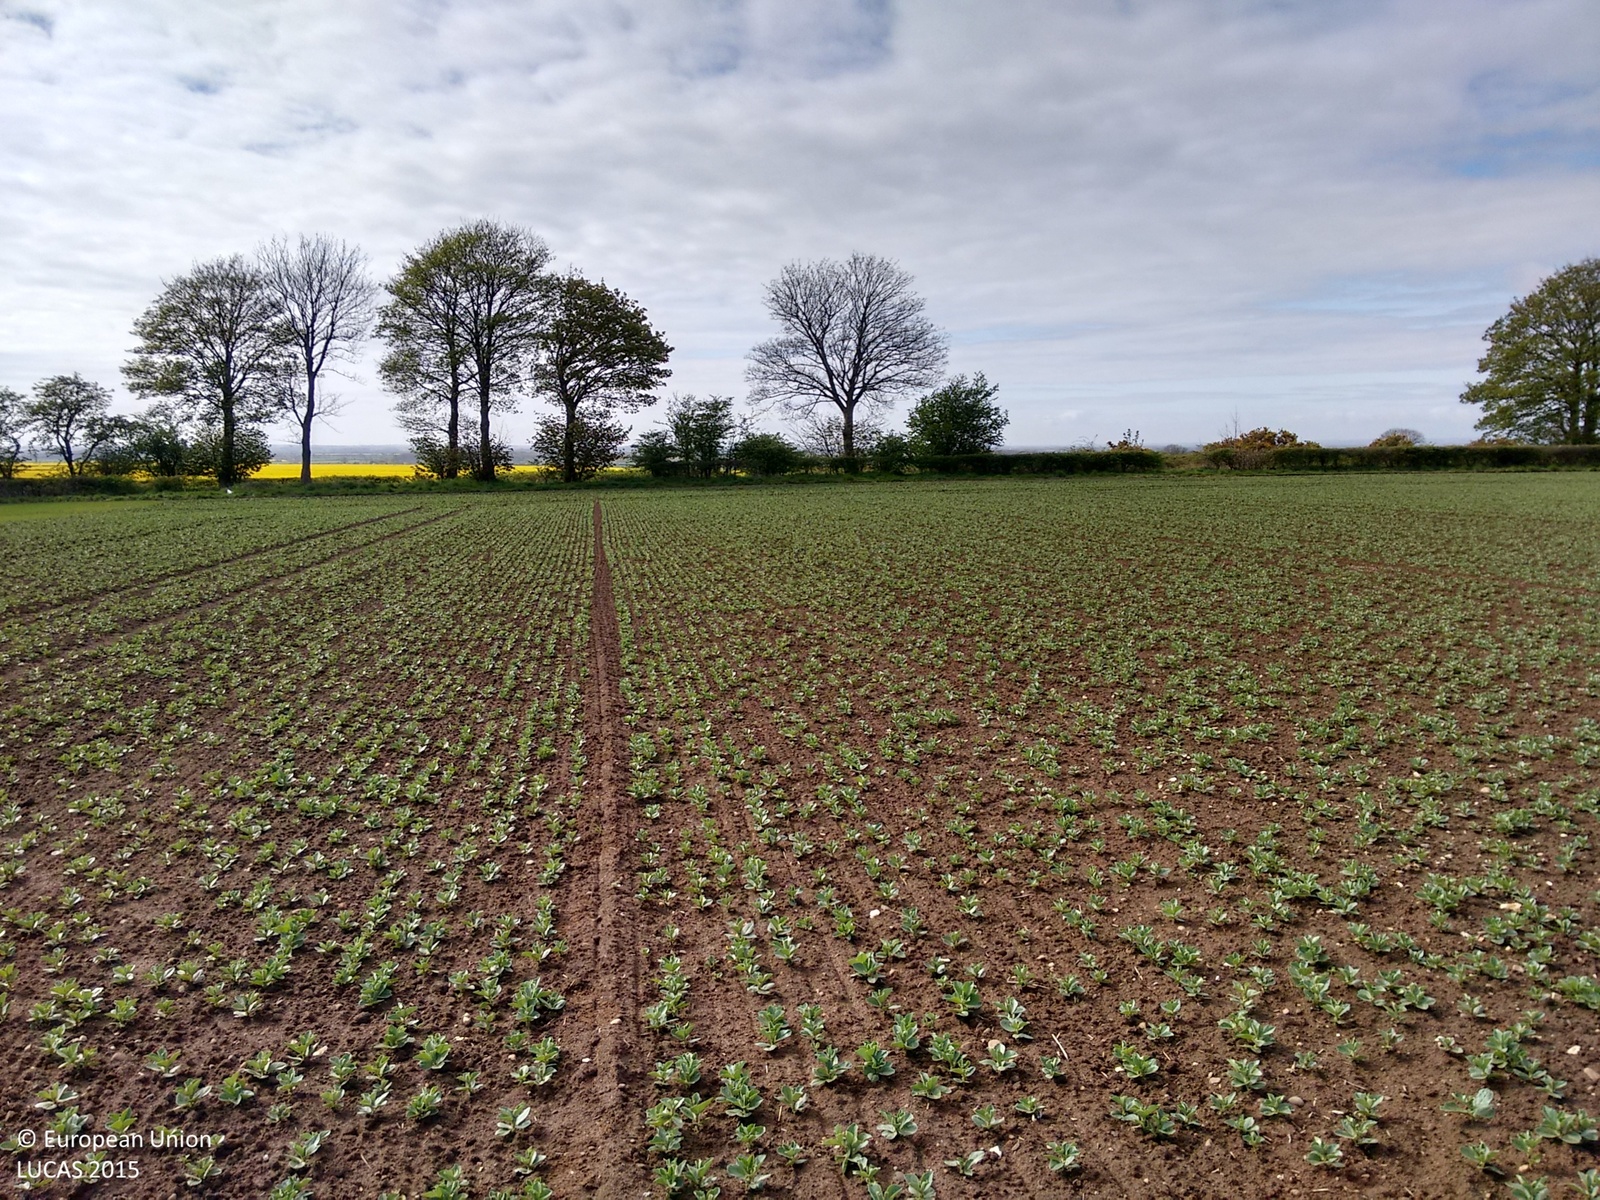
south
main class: Cropland
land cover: Dry pulses
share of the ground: 10 - 25 %
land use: Agriculture (excluding fallow land and kitchen gardens)
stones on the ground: < 10 %
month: May
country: GB
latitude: 54.0635
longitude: -0.3480
